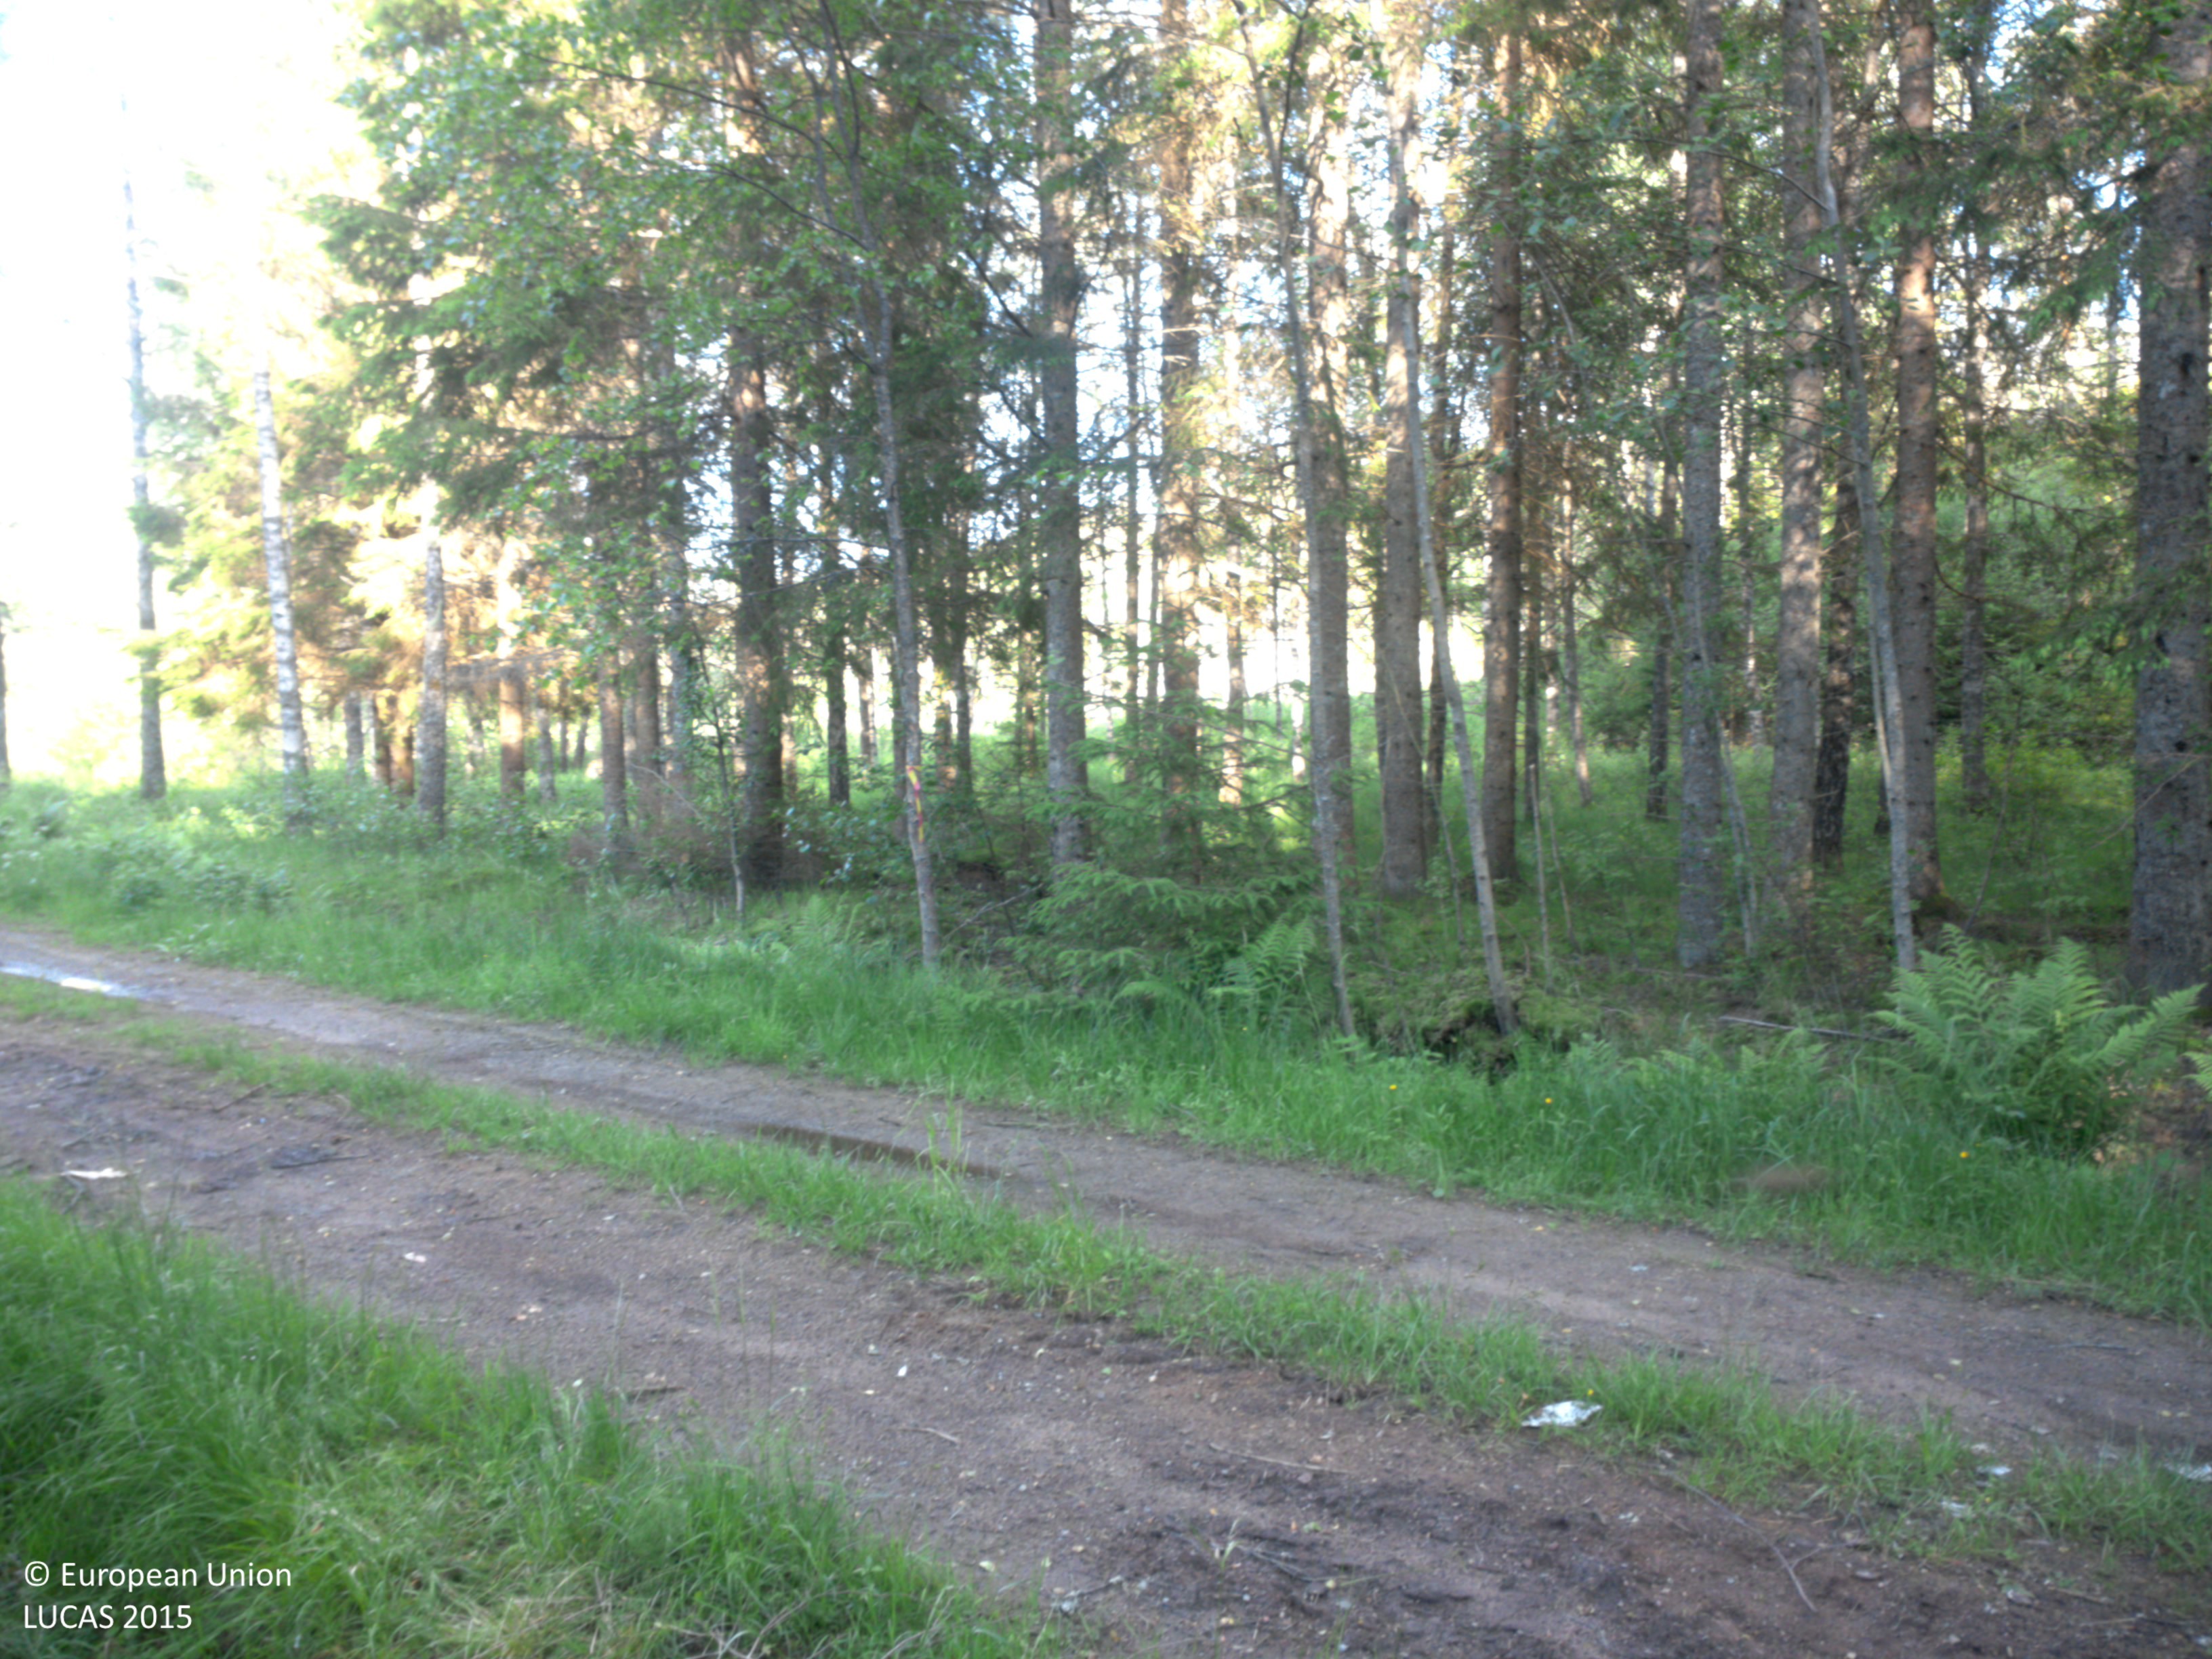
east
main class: Woodland
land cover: Spruce dominated mixed woodland
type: boreal forest
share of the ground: 50 - 75 %
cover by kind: coniferous forest trees 40 %, herbaceous plants 30 %, broadleaved forest trees 25 %, shrubs 5 %
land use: Forestry
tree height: > 5 m
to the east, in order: Spruce dominated mixed woodland; Grass margins; Paved roads, cycling and walking lanes; Grass margins; Ditches and canals; Spruce dominated coniferous woodland; Broadleaved woodland; Shrubland with sparse tree cover; Ditches and canals; Shrubland with sparse tree cover; Broadleaved woodland; Ditches and canals; Shrubland with sparse tree cover; Ditches and canals; Abandoned hedges; Grassland with sparse tree/shrub cover
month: June
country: SE
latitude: 58.8583
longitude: 11.5393
